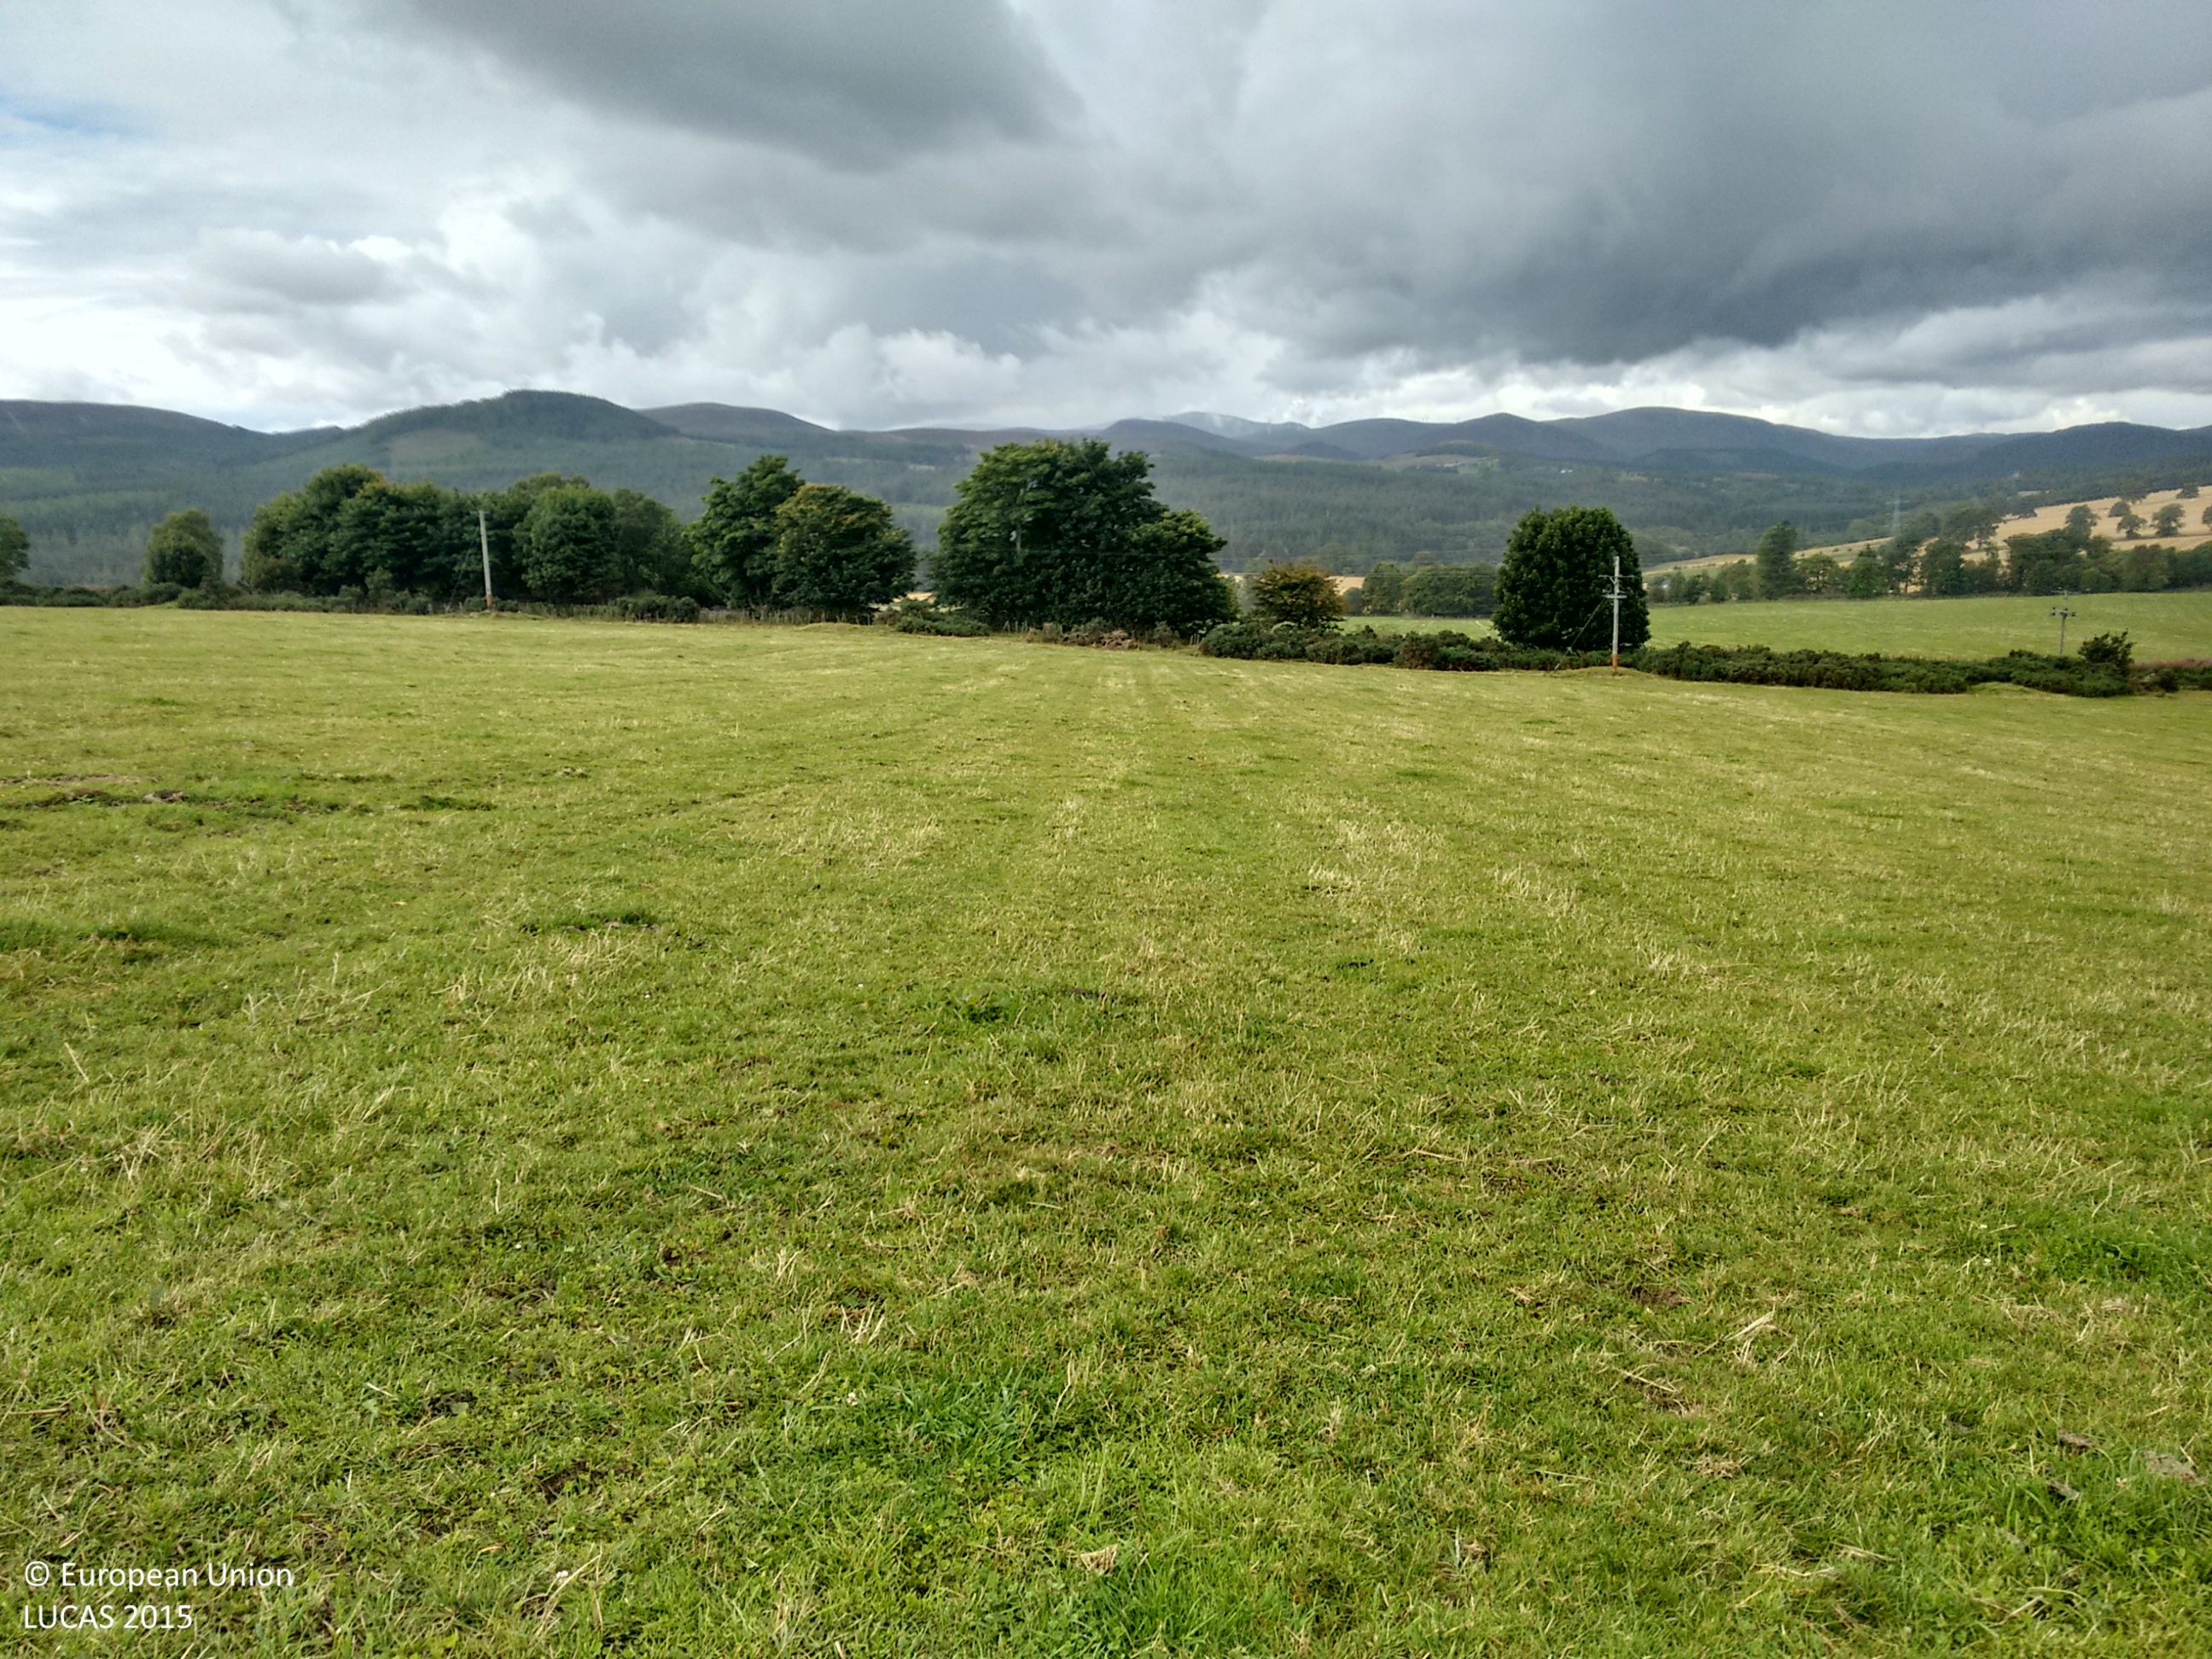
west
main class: Grassland
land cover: Grassland without tree/shrub cover
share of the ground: > 75 %
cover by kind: herbaceous plants 100 %
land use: Agriculture (excluding fallow land and kitchen gardens)
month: September
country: GB
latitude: 57.7267
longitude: -4.2736
